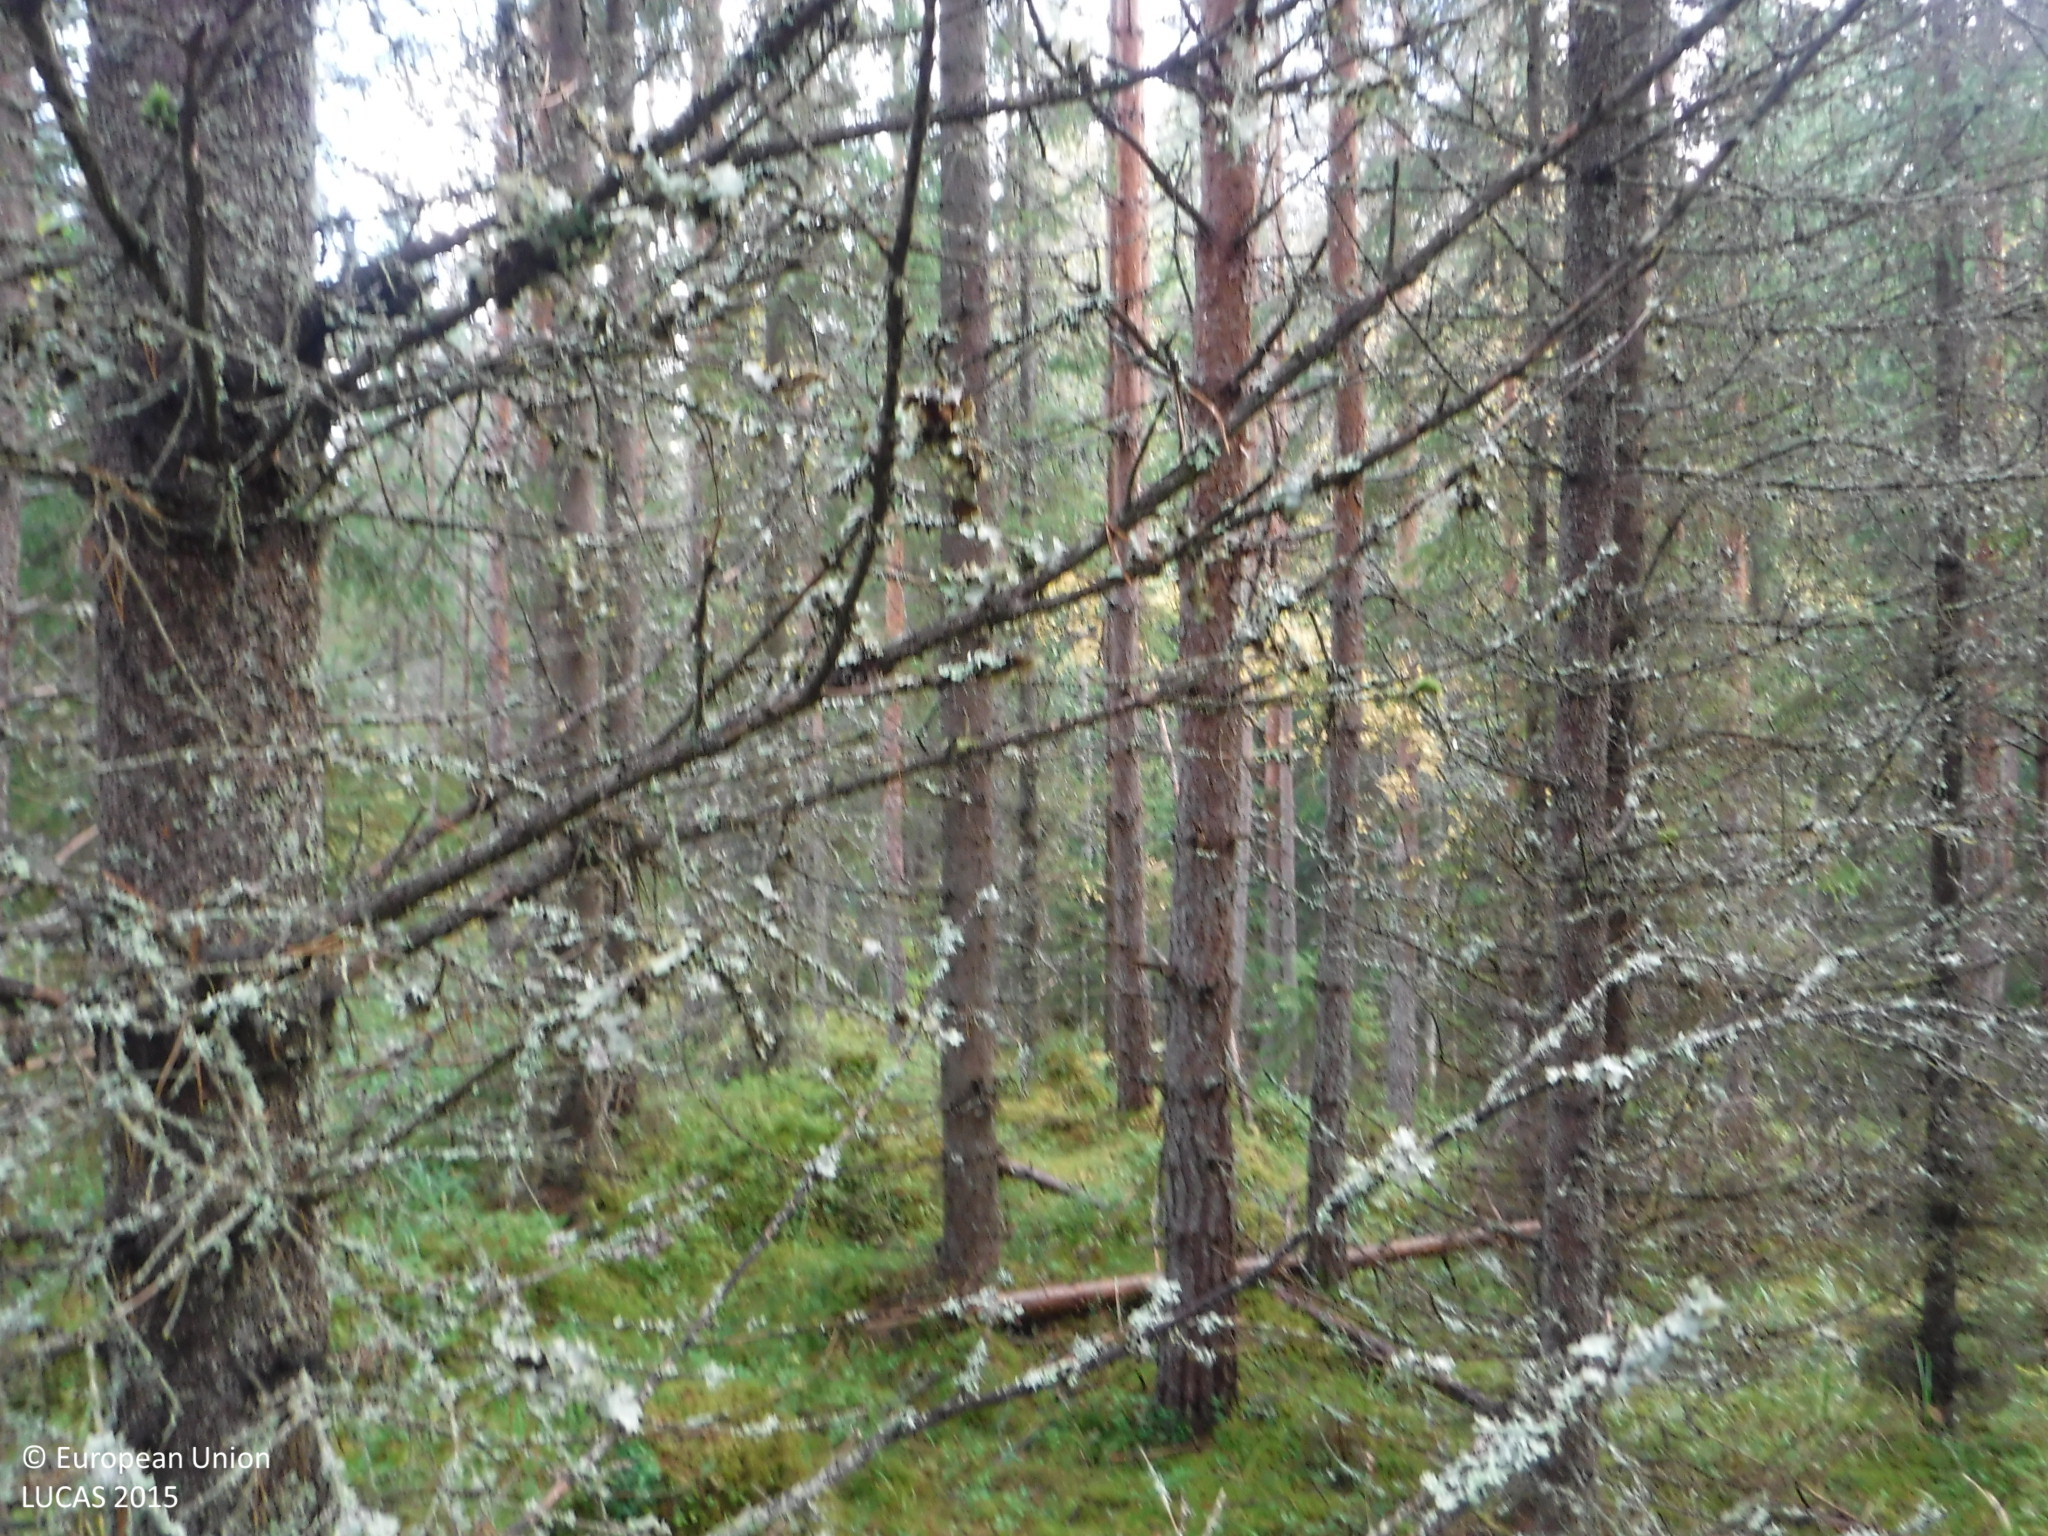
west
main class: Woodland
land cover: Other coniferous woodland
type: boreal forest
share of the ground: 50 - 75 %
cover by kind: coniferous forest trees 70 %, lichens and mosses 20 %, shrubs 10 %
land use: Amenities, museums, leisure
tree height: > 5 m
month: September
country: FI
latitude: 61.6805
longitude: 24.1680
